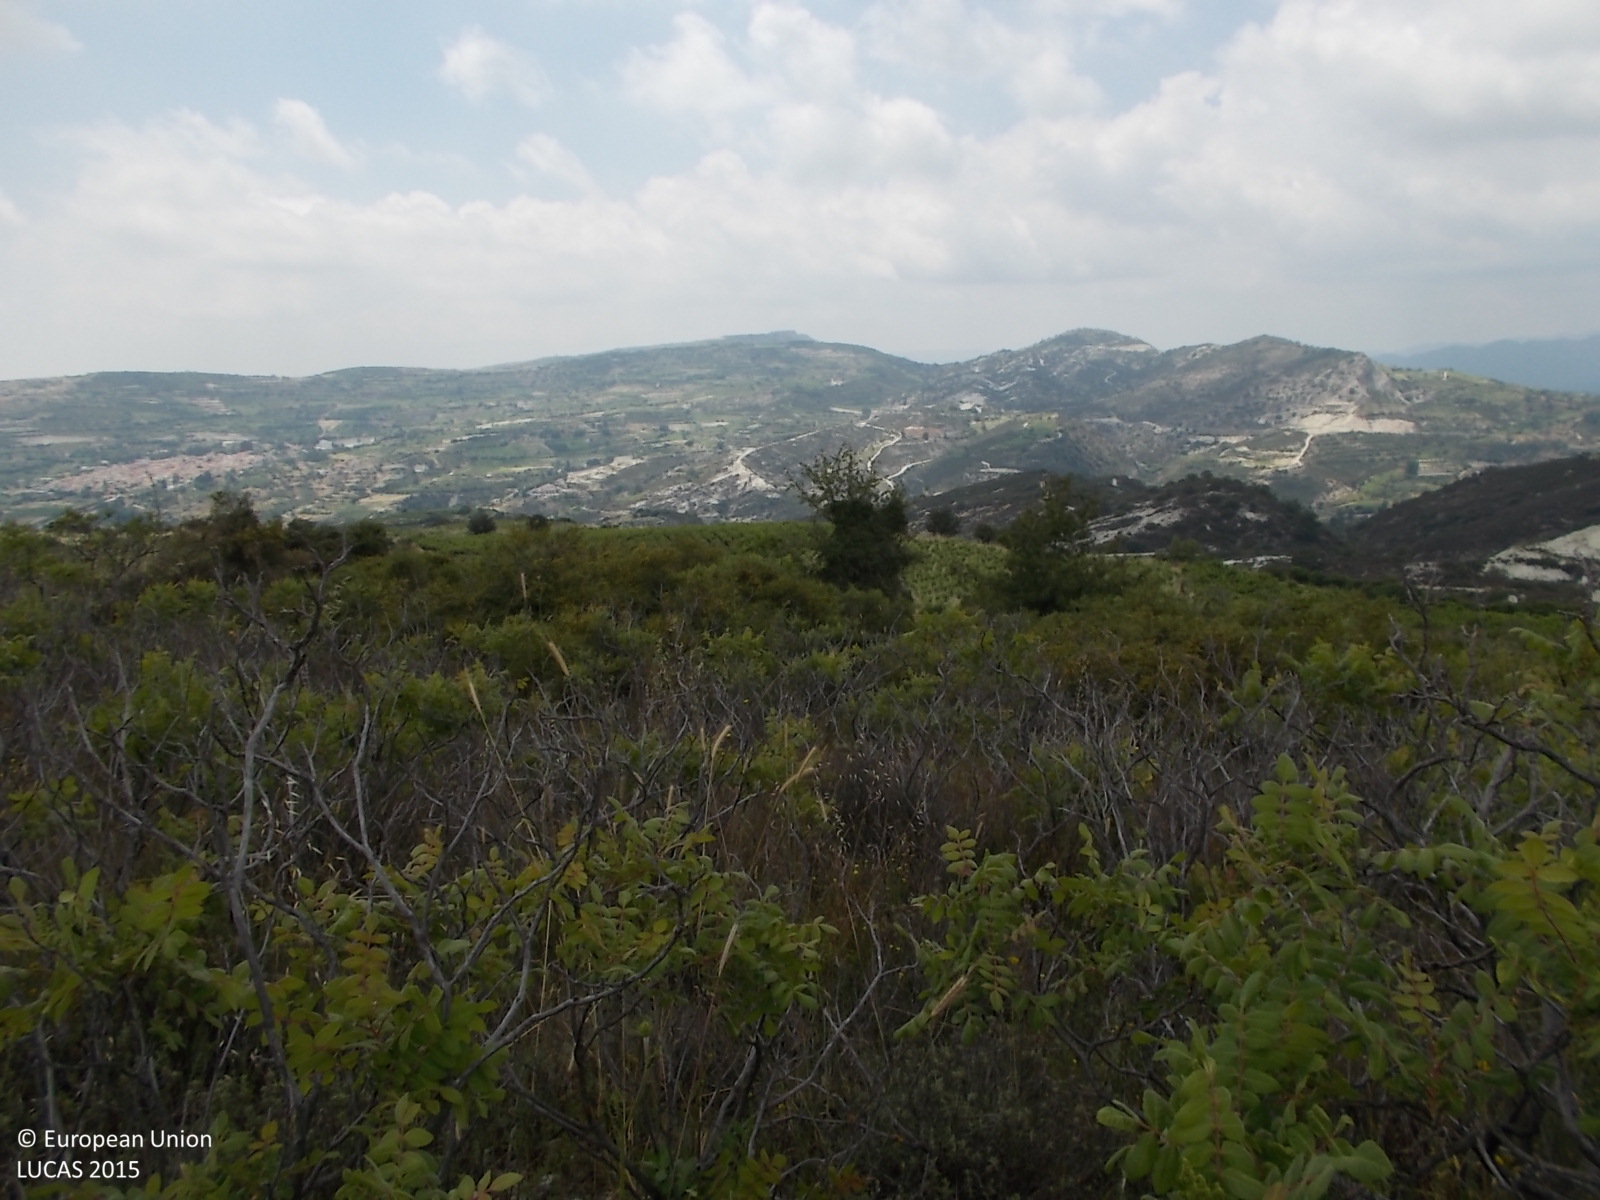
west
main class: Cropland
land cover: Cherry fruit
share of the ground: 50 - 75 %
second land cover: Shrubland without tree cover
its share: 25 - 50 %
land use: Abandoned areas
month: June
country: CY
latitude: 34.8545
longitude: 32.8360
